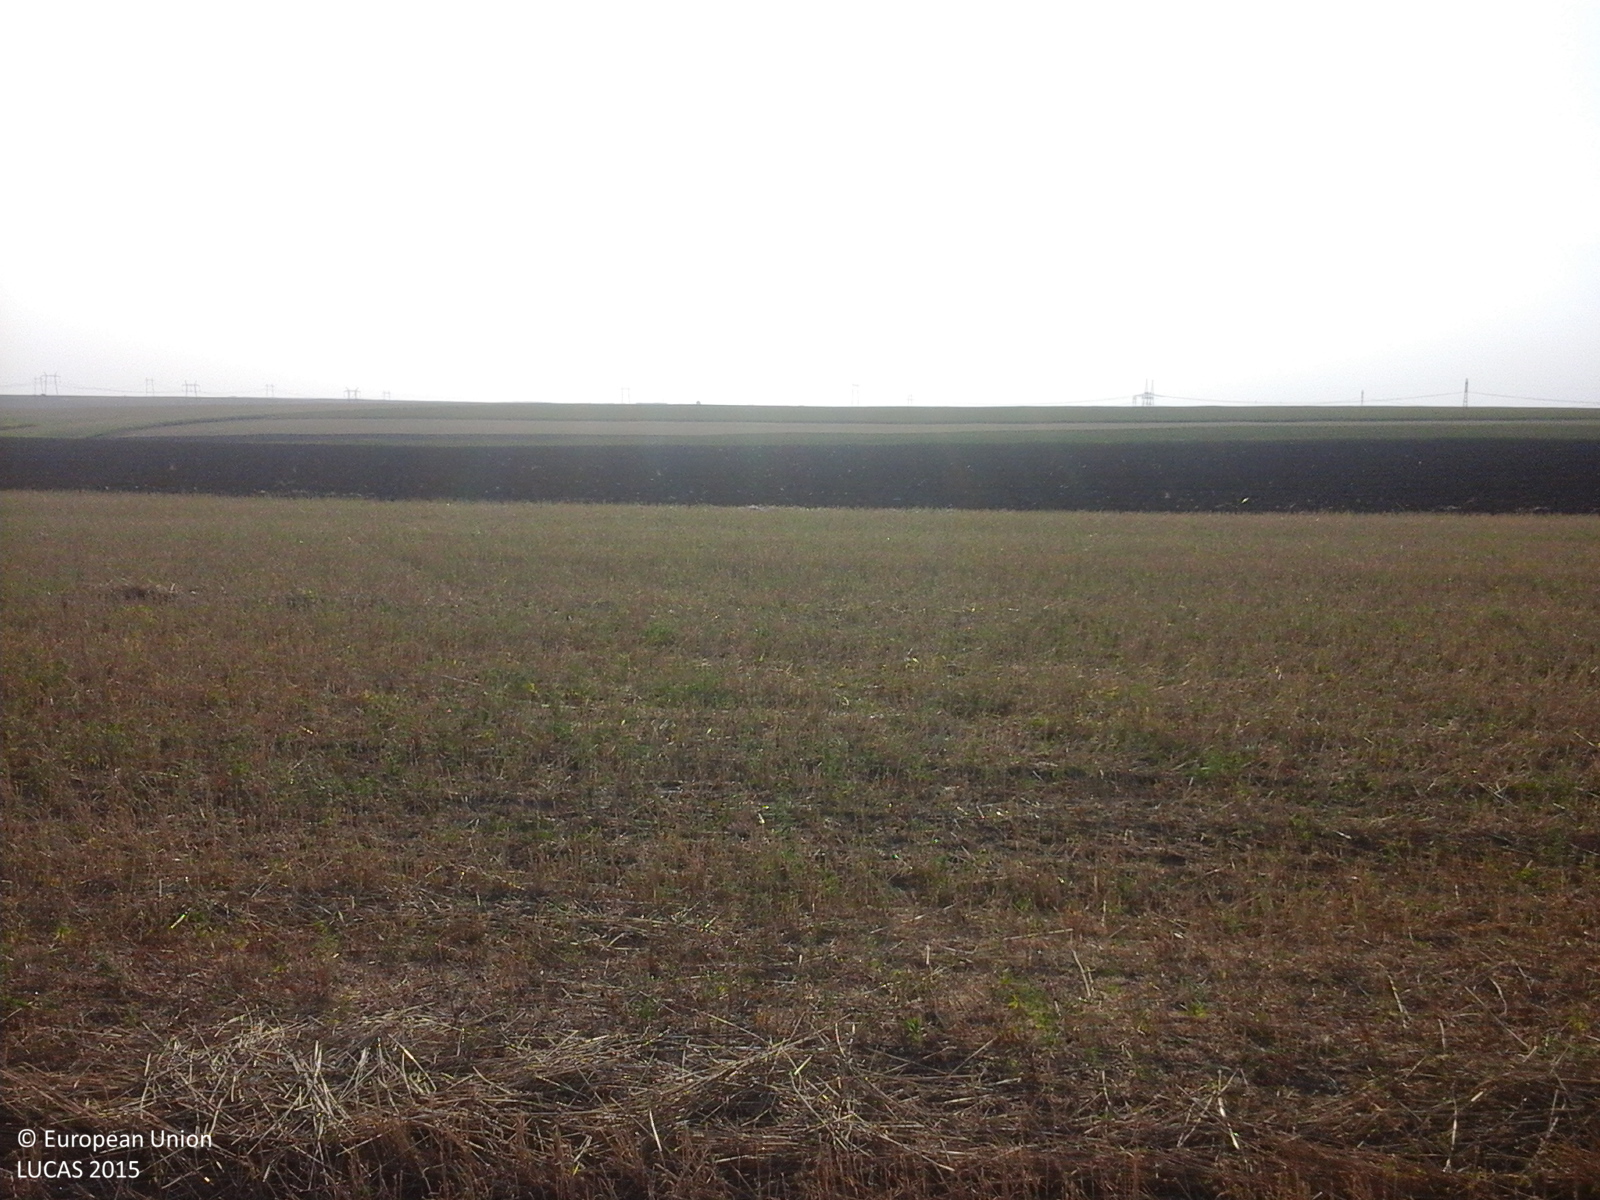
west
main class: Cropland
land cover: Sunflower
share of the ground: > 75 %
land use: Agriculture (excluding fallow land and kitchen gardens)
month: August
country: RO
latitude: 44.0624
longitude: 28.0435
